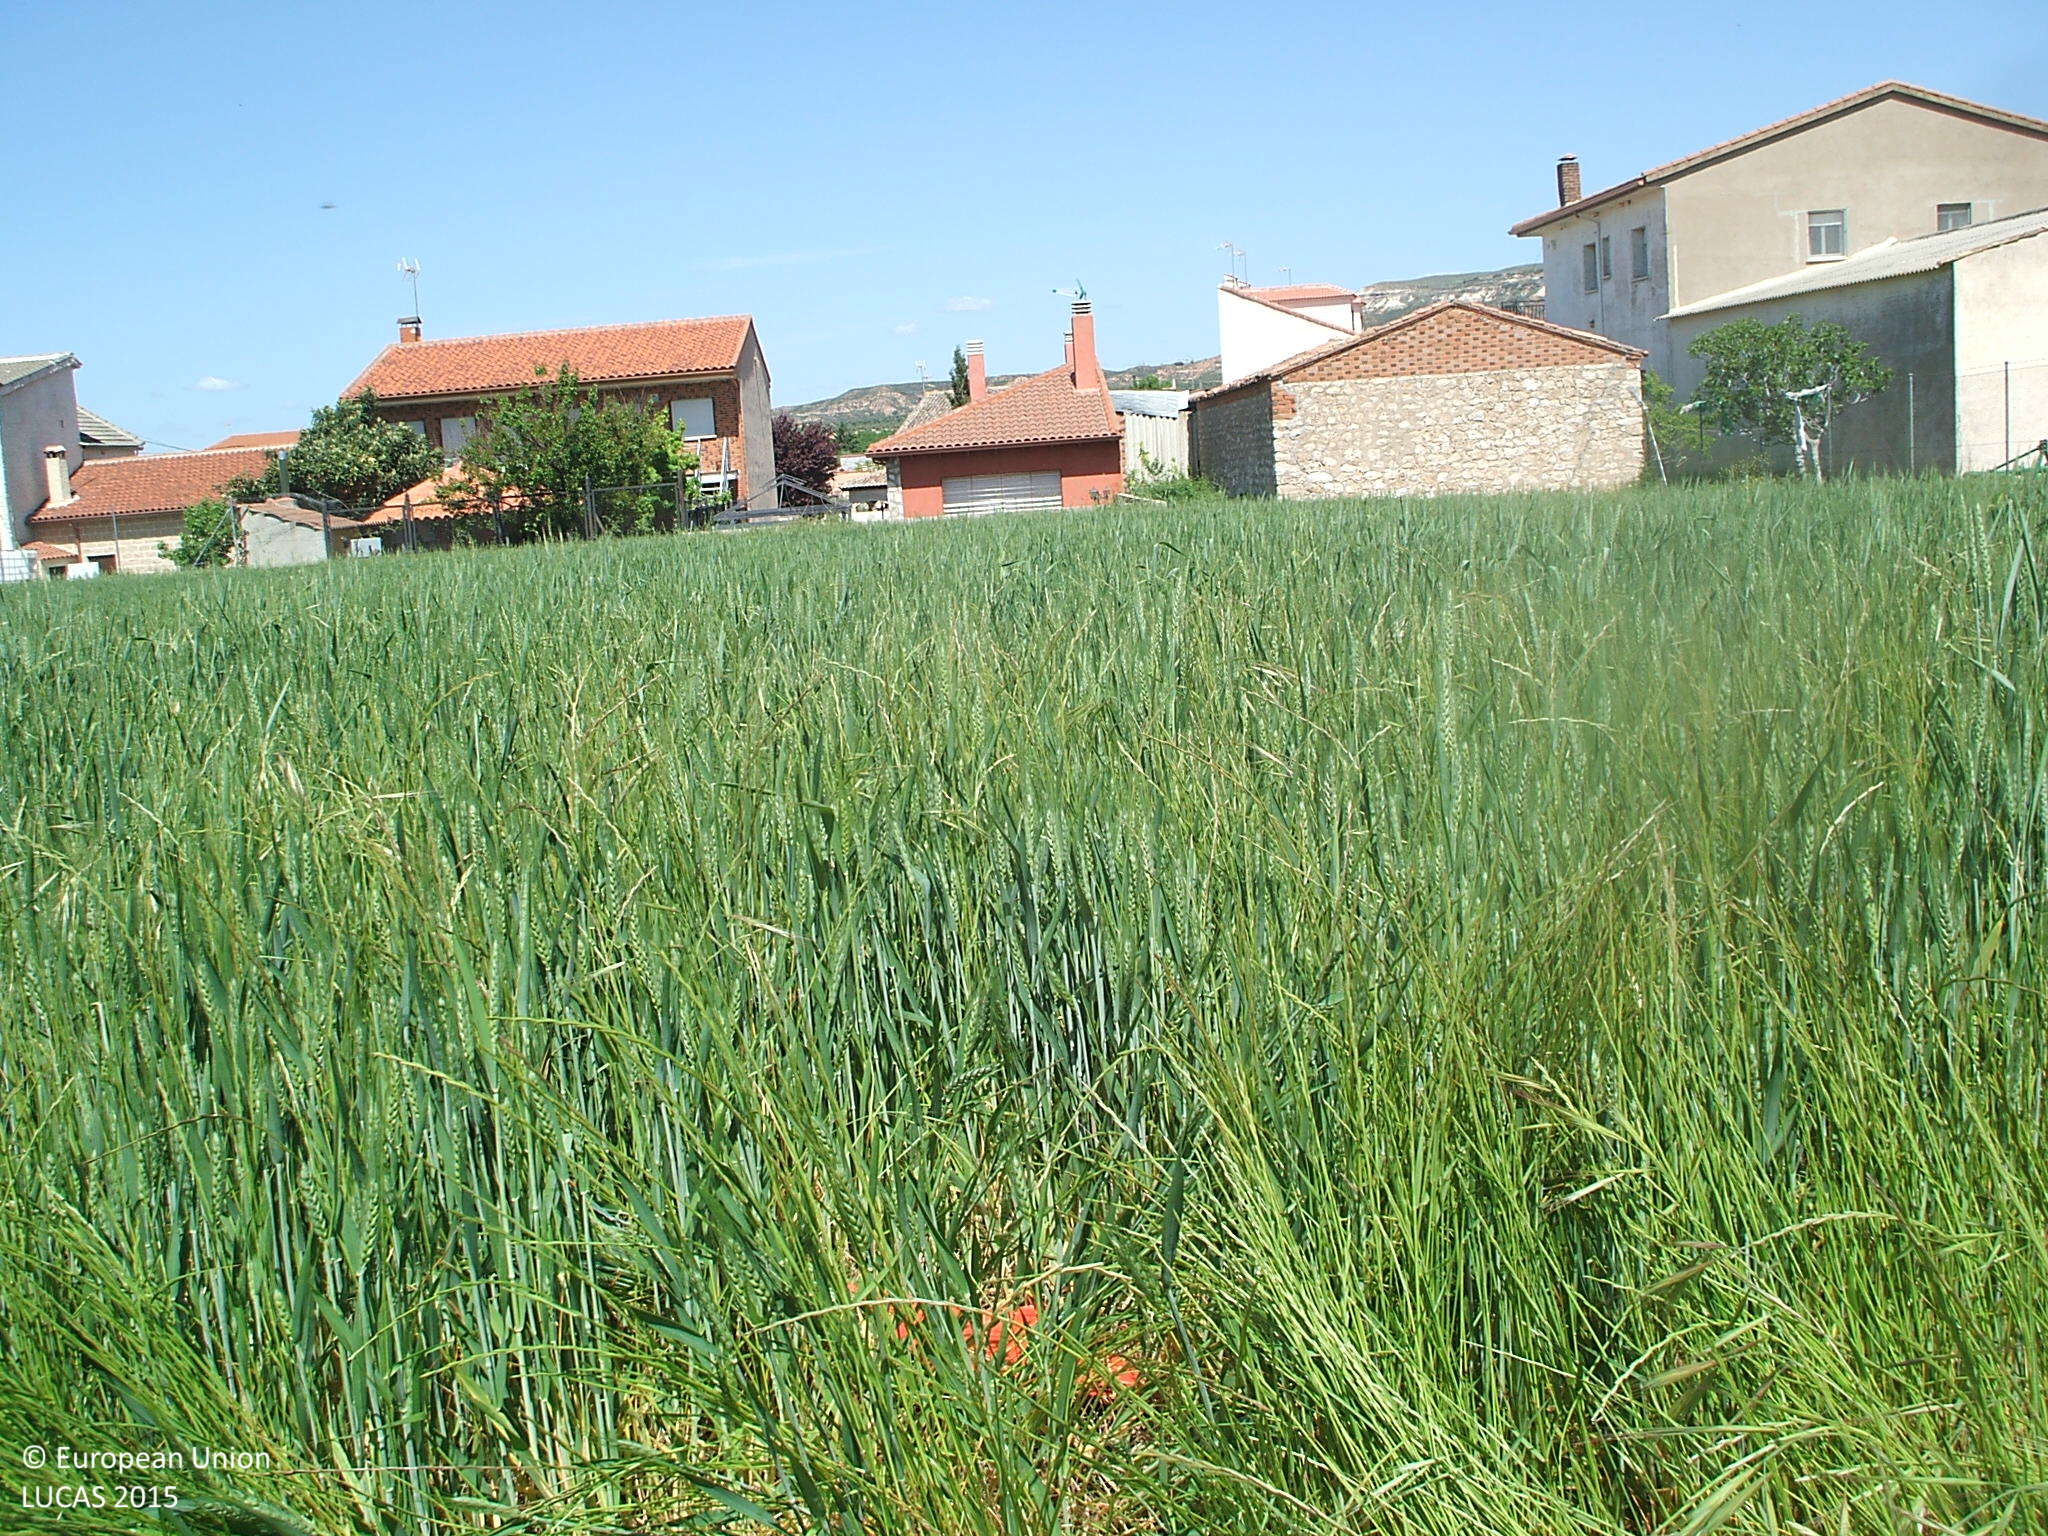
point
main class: Cropland
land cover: Common wheat
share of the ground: > 75 %
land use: Agriculture (excluding fallow land and kitchen gardens)
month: May
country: ES
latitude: 40.8083
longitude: -2.9901
